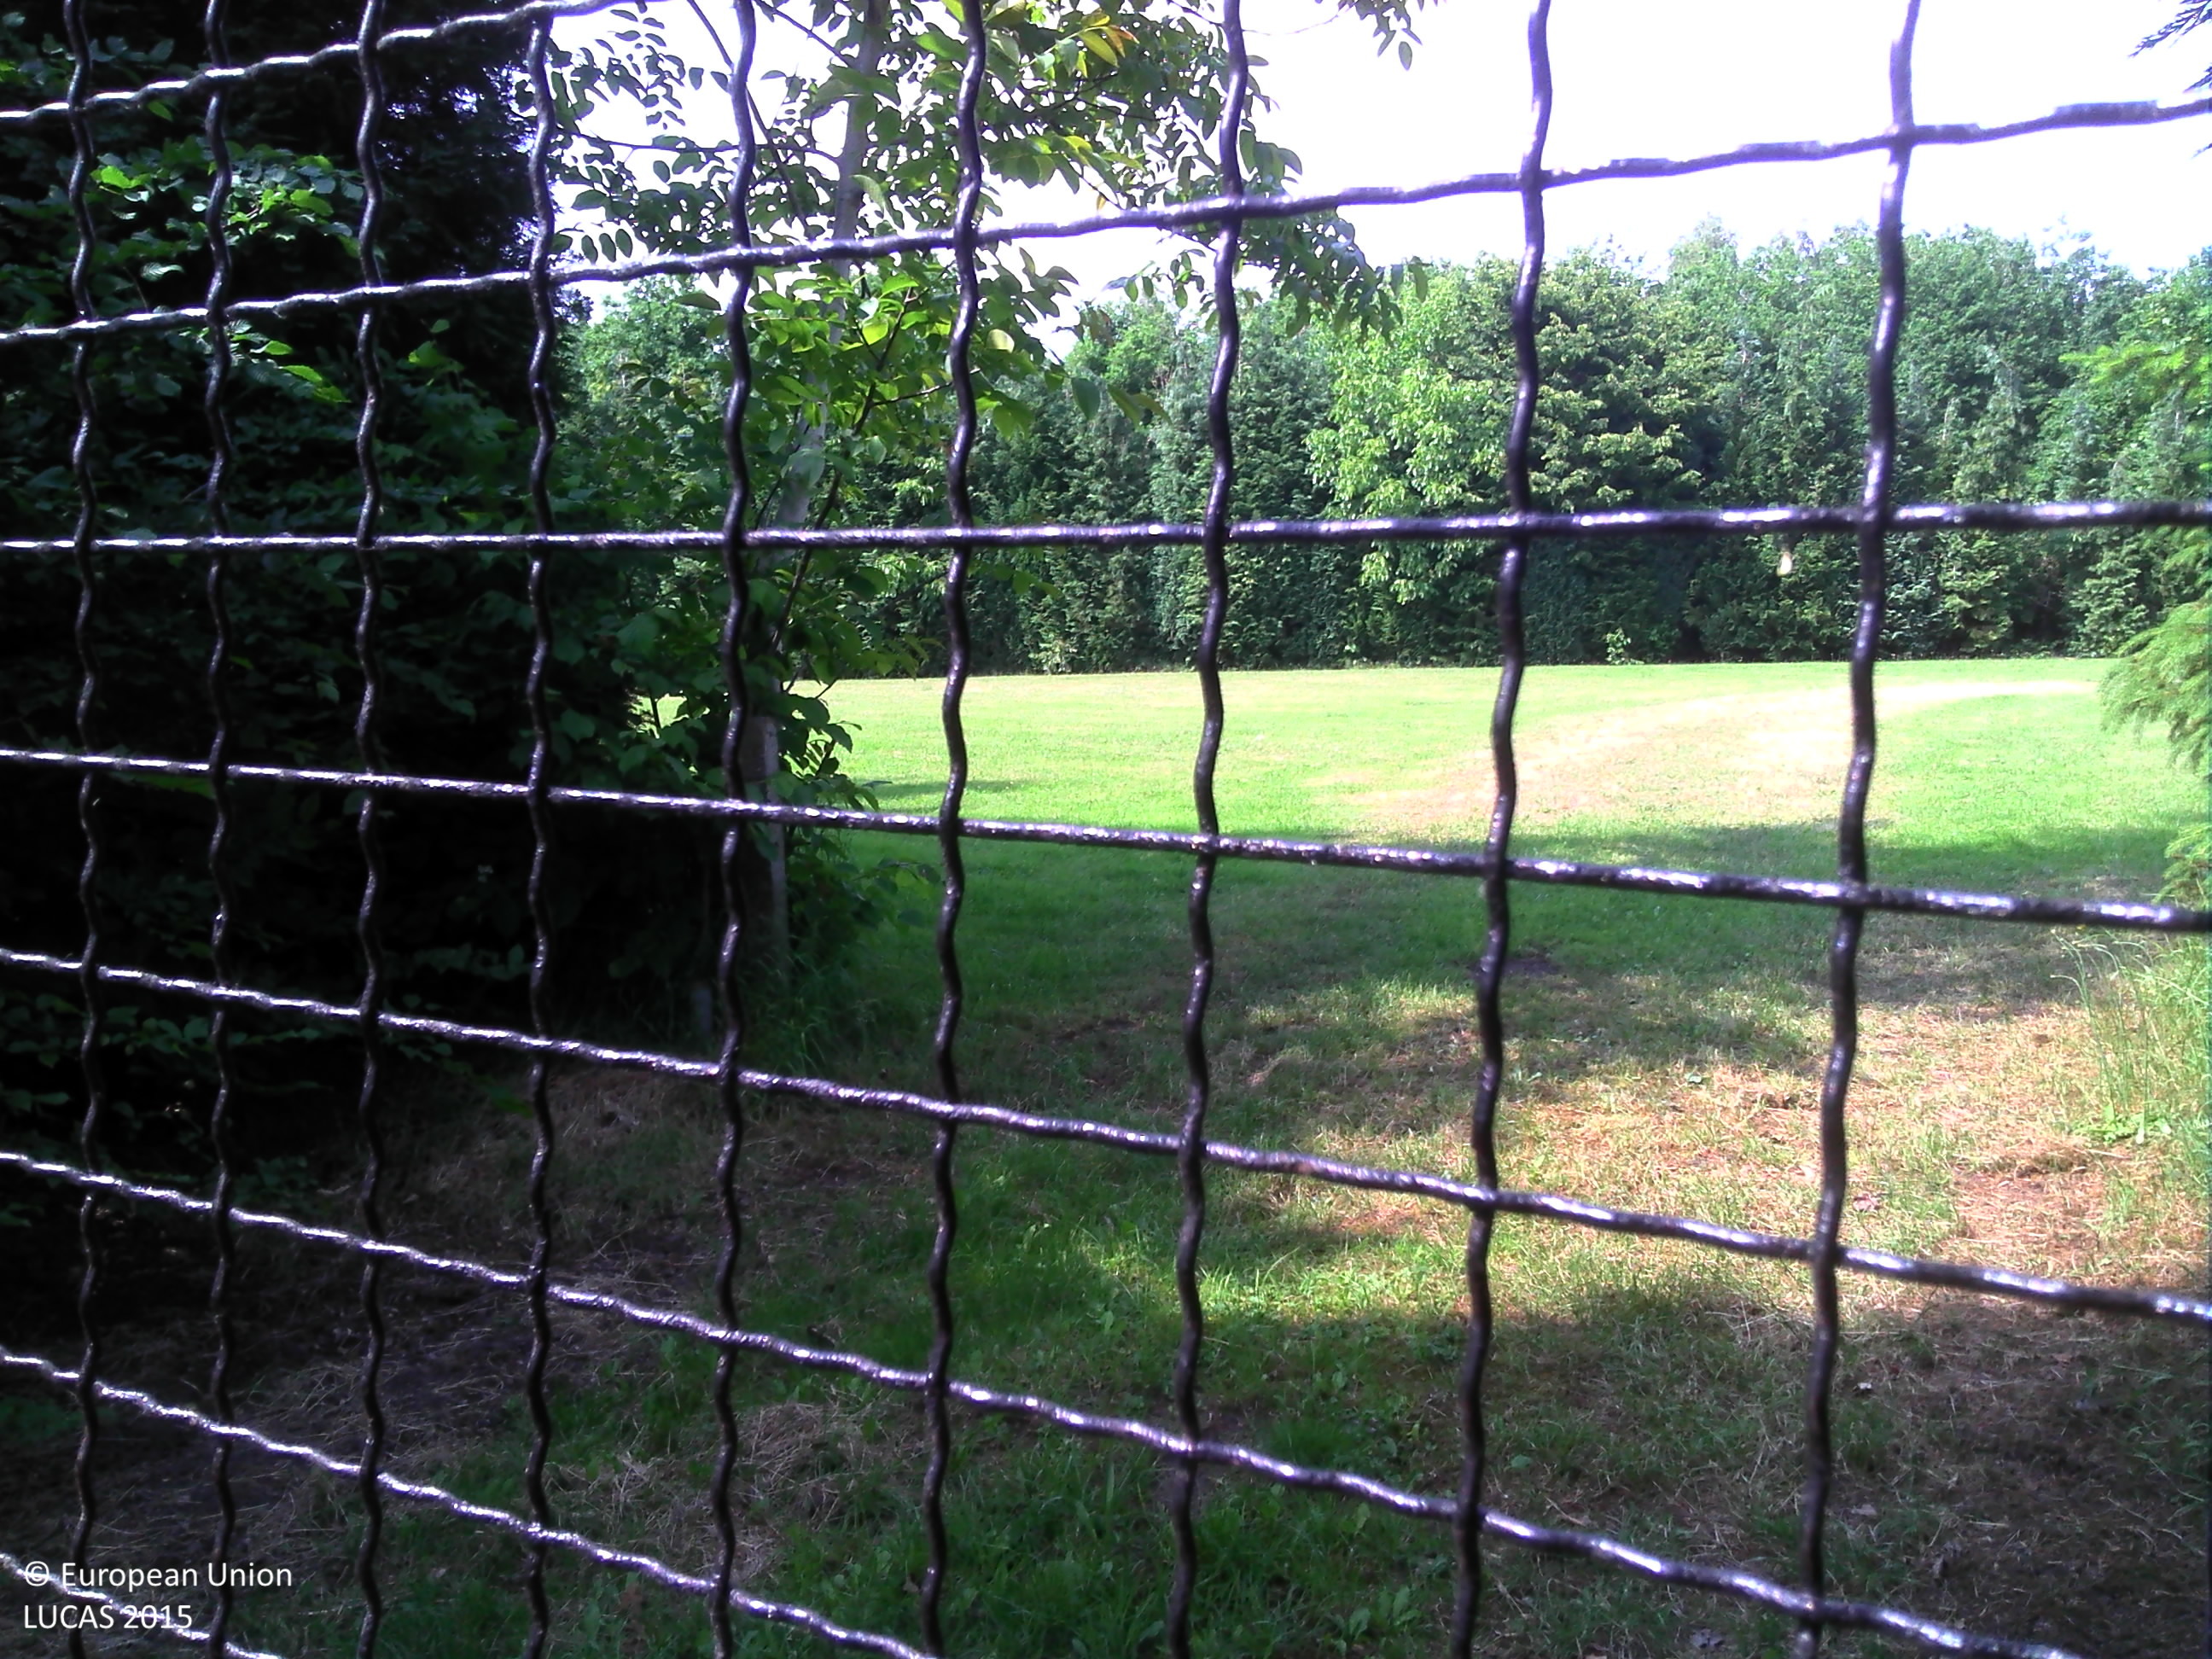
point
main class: Grassland
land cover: Grassland without tree/shrub cover
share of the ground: > 75 %
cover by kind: herbaceous plants 100 %
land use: Residential
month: June
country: BE
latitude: 51.0554
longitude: 5.1896
